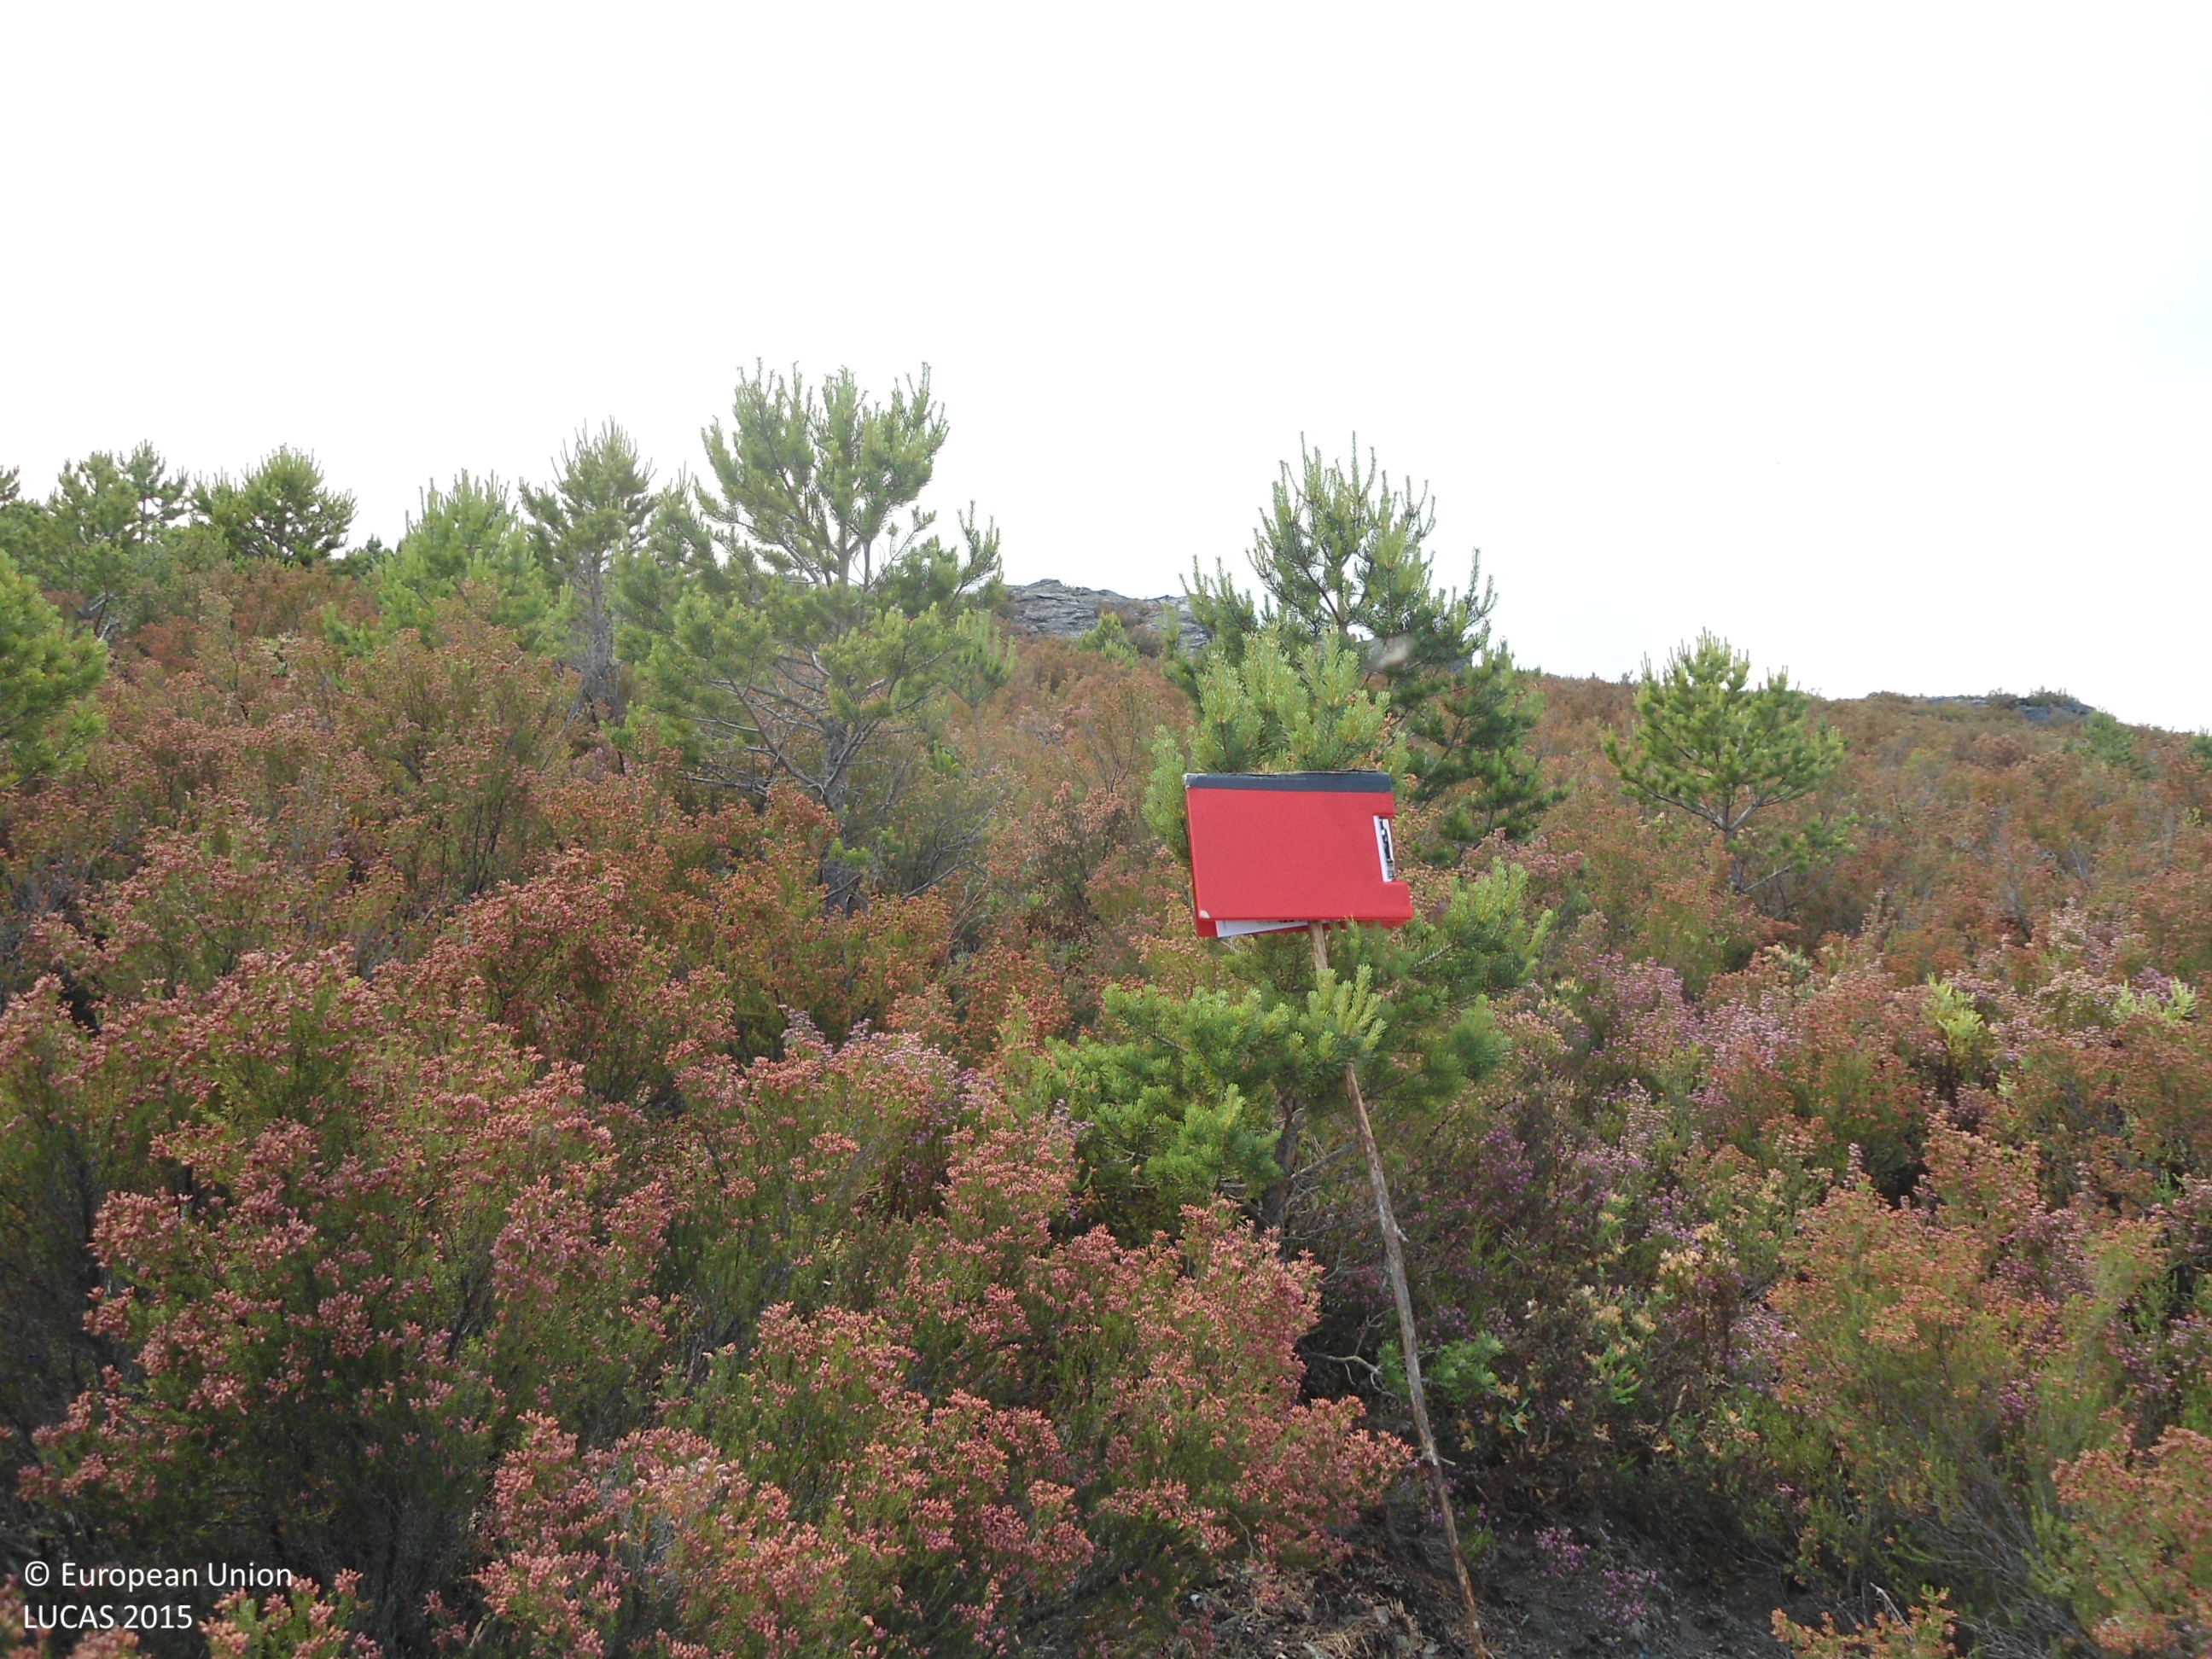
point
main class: Woodland
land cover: Pine dominated coniferous woodland
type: coniferous forest of the mediterranean region
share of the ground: 10 - 25 %
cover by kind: shrubs 90 %, coniferous forest trees 10 %
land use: Forestry
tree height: < 5 m
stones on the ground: > 50 %
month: June
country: ES
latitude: 42.0037
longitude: -6.7408
